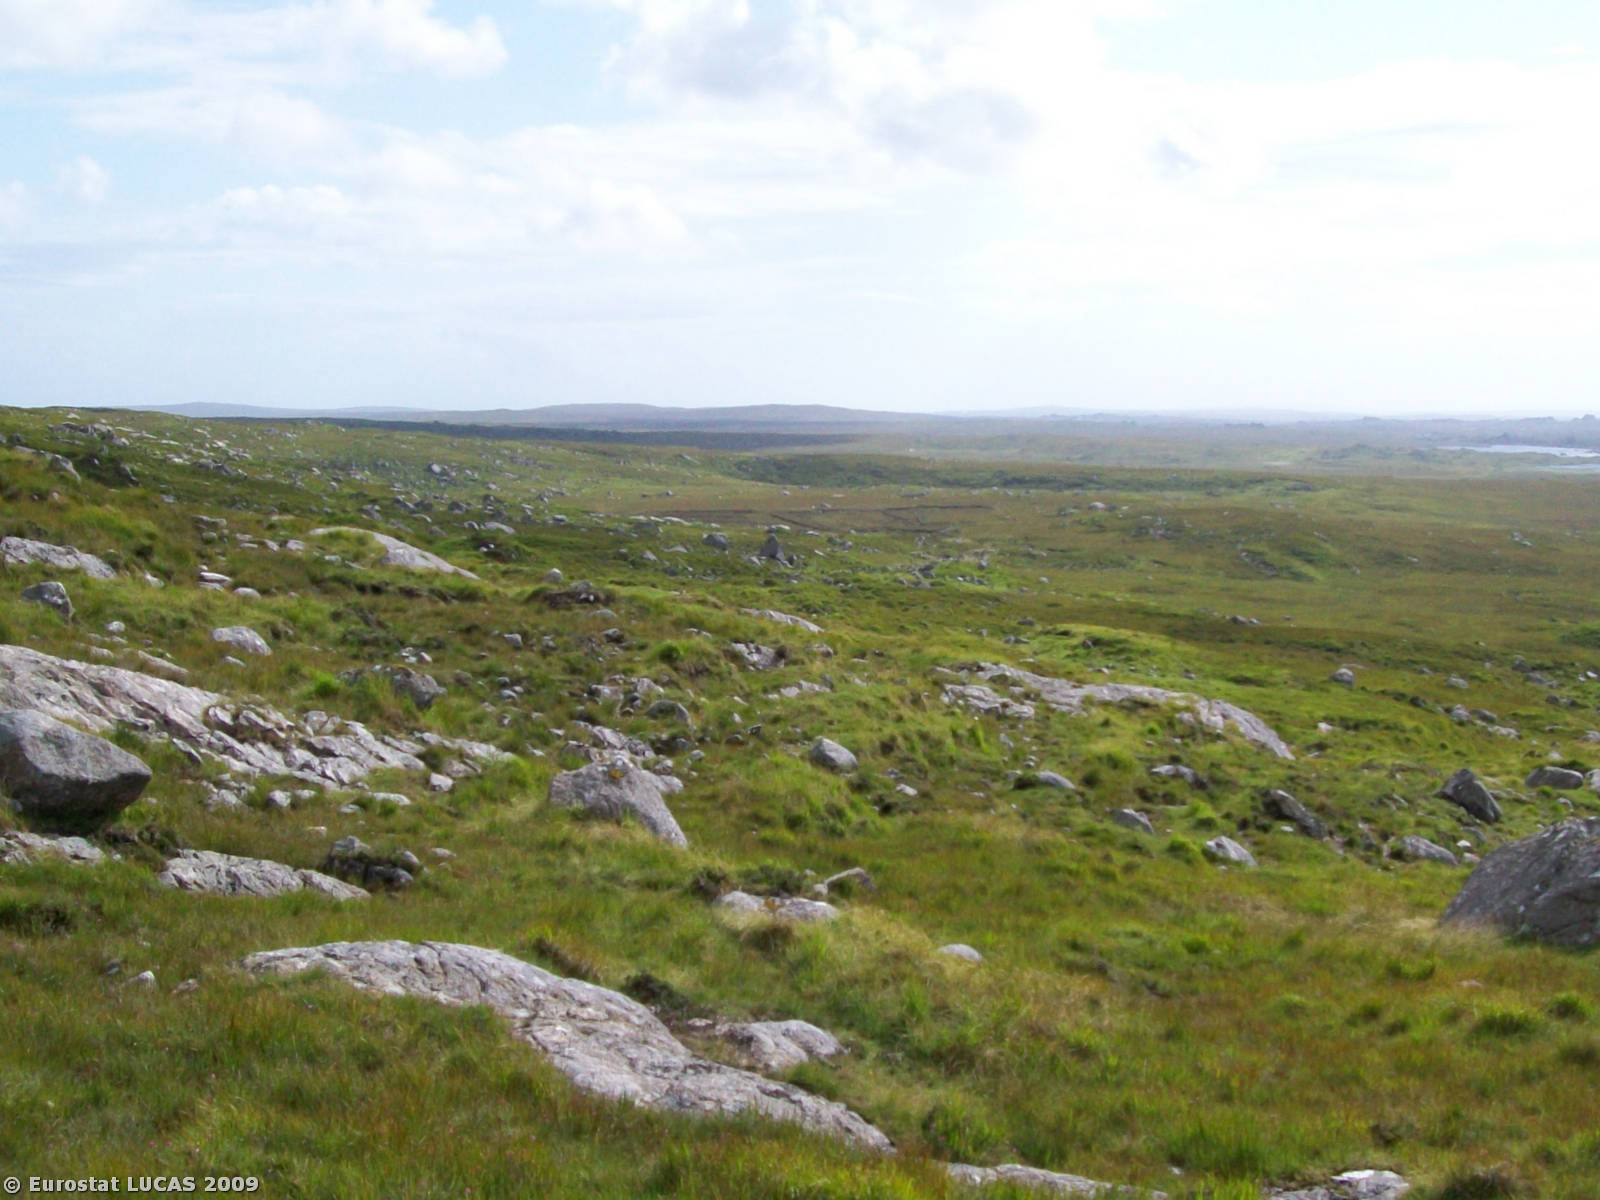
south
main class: Grassland
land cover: Grassland without tree/shrub cover
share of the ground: > 75 %
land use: Nature reserves
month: August
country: IE
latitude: 53.3884
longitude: -9.4935
